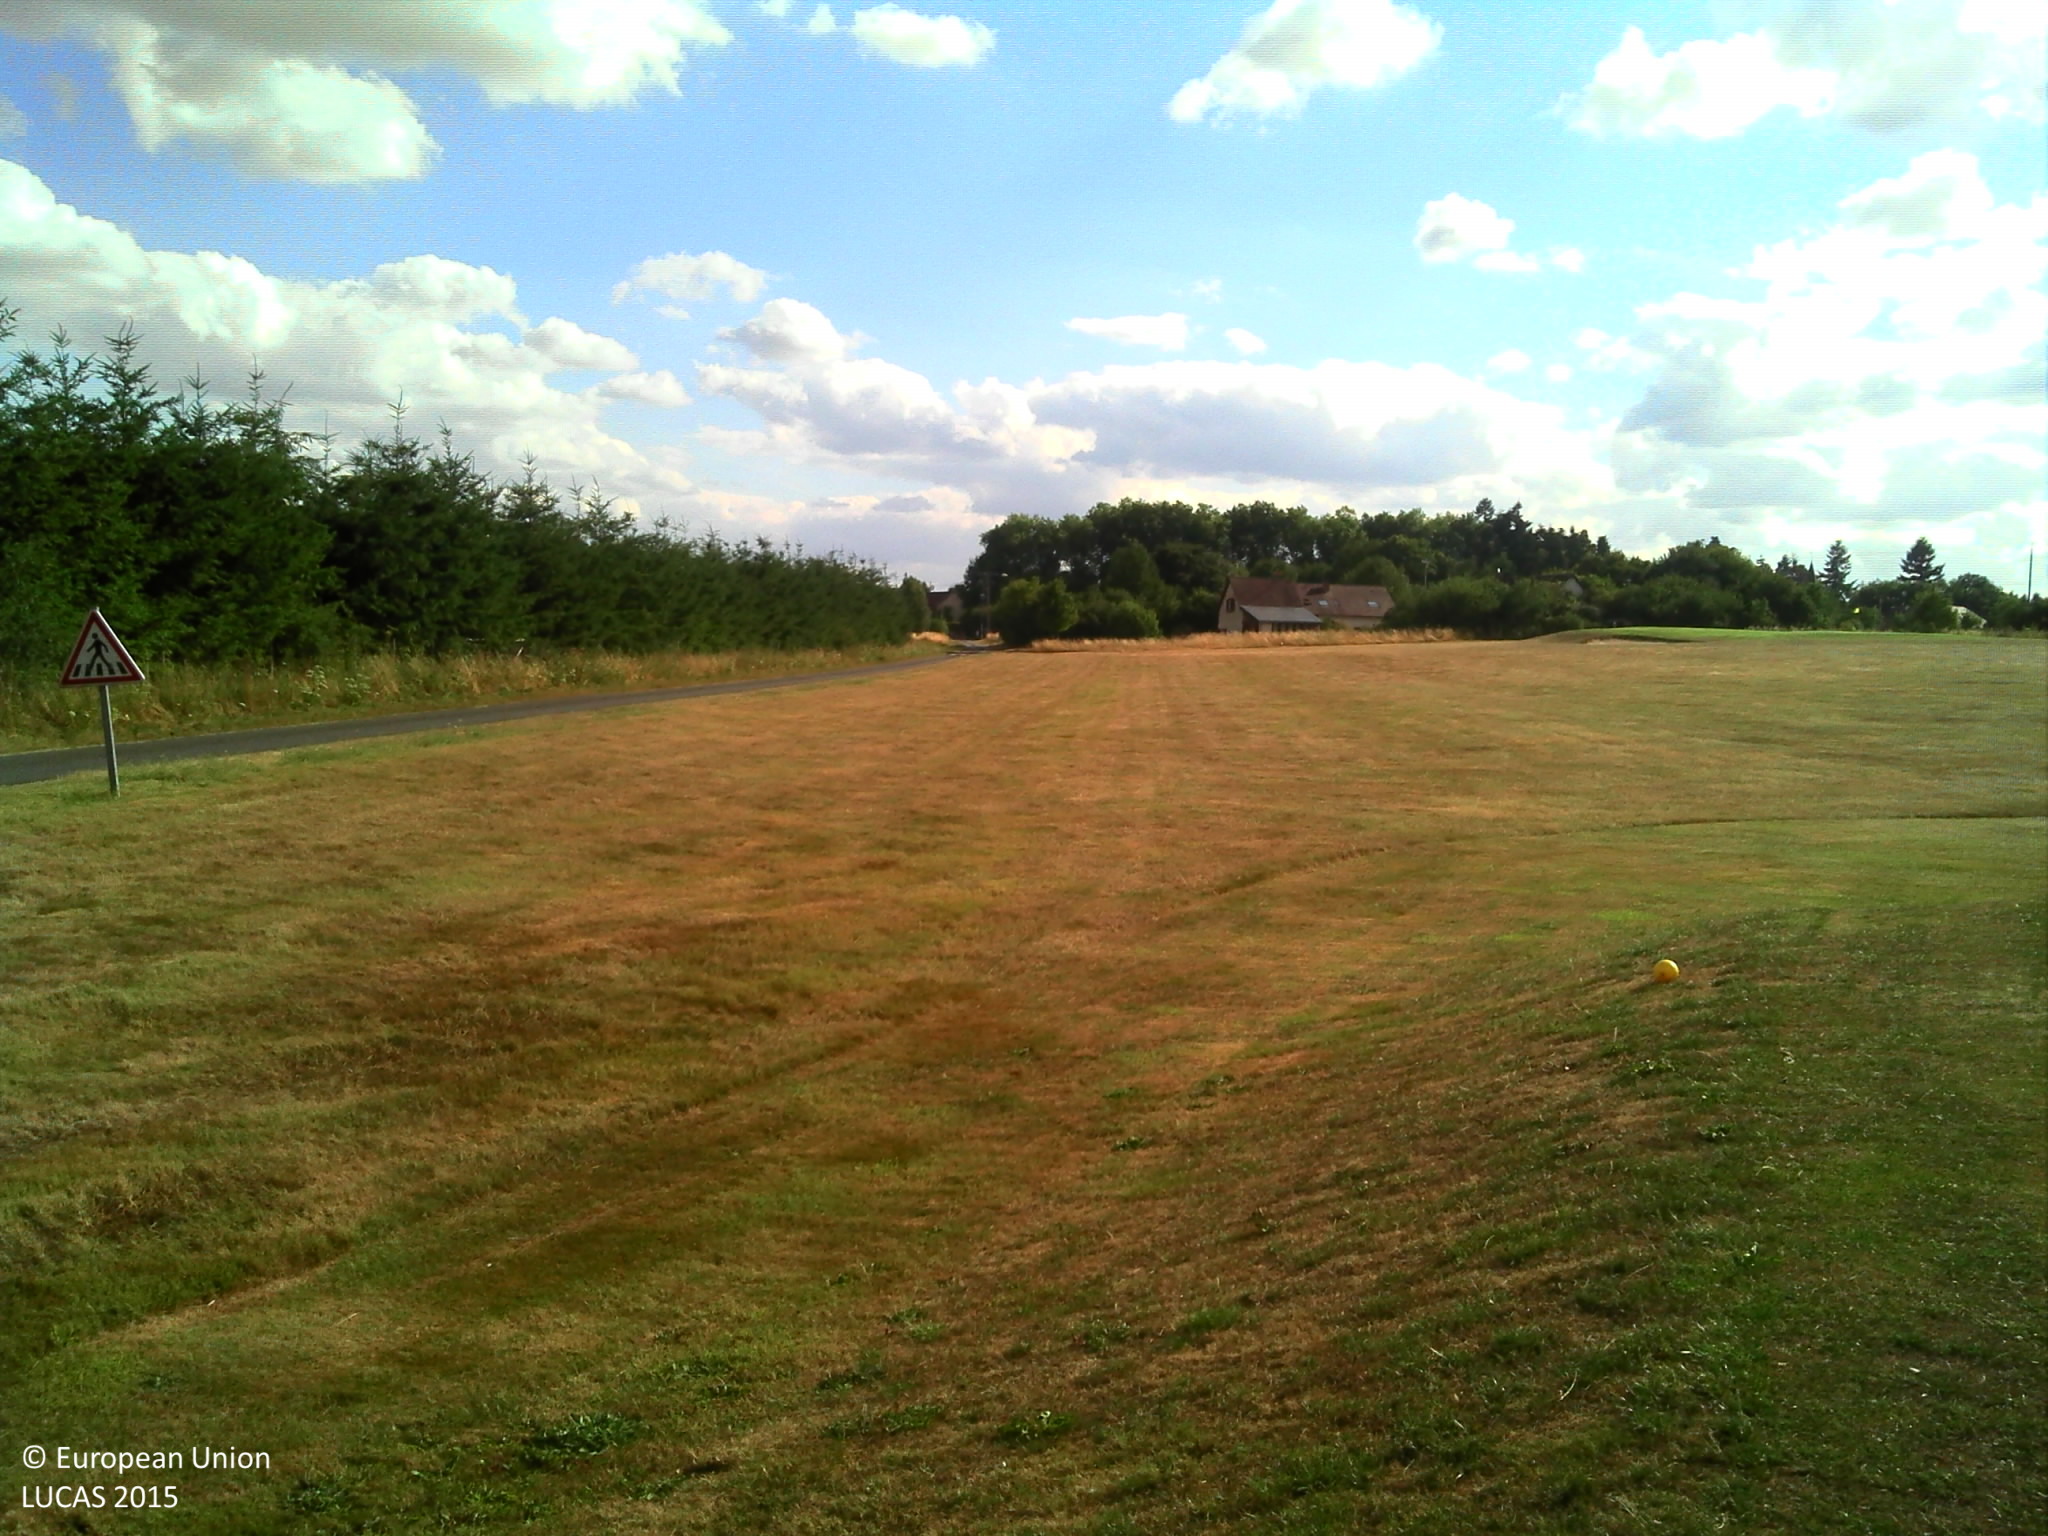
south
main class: Grassland
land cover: Grassland without tree/shrub cover
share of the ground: > 75 %
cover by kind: herbaceous plants 100 %
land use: Sport
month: July
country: FR
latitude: 48.5956
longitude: 1.2080
